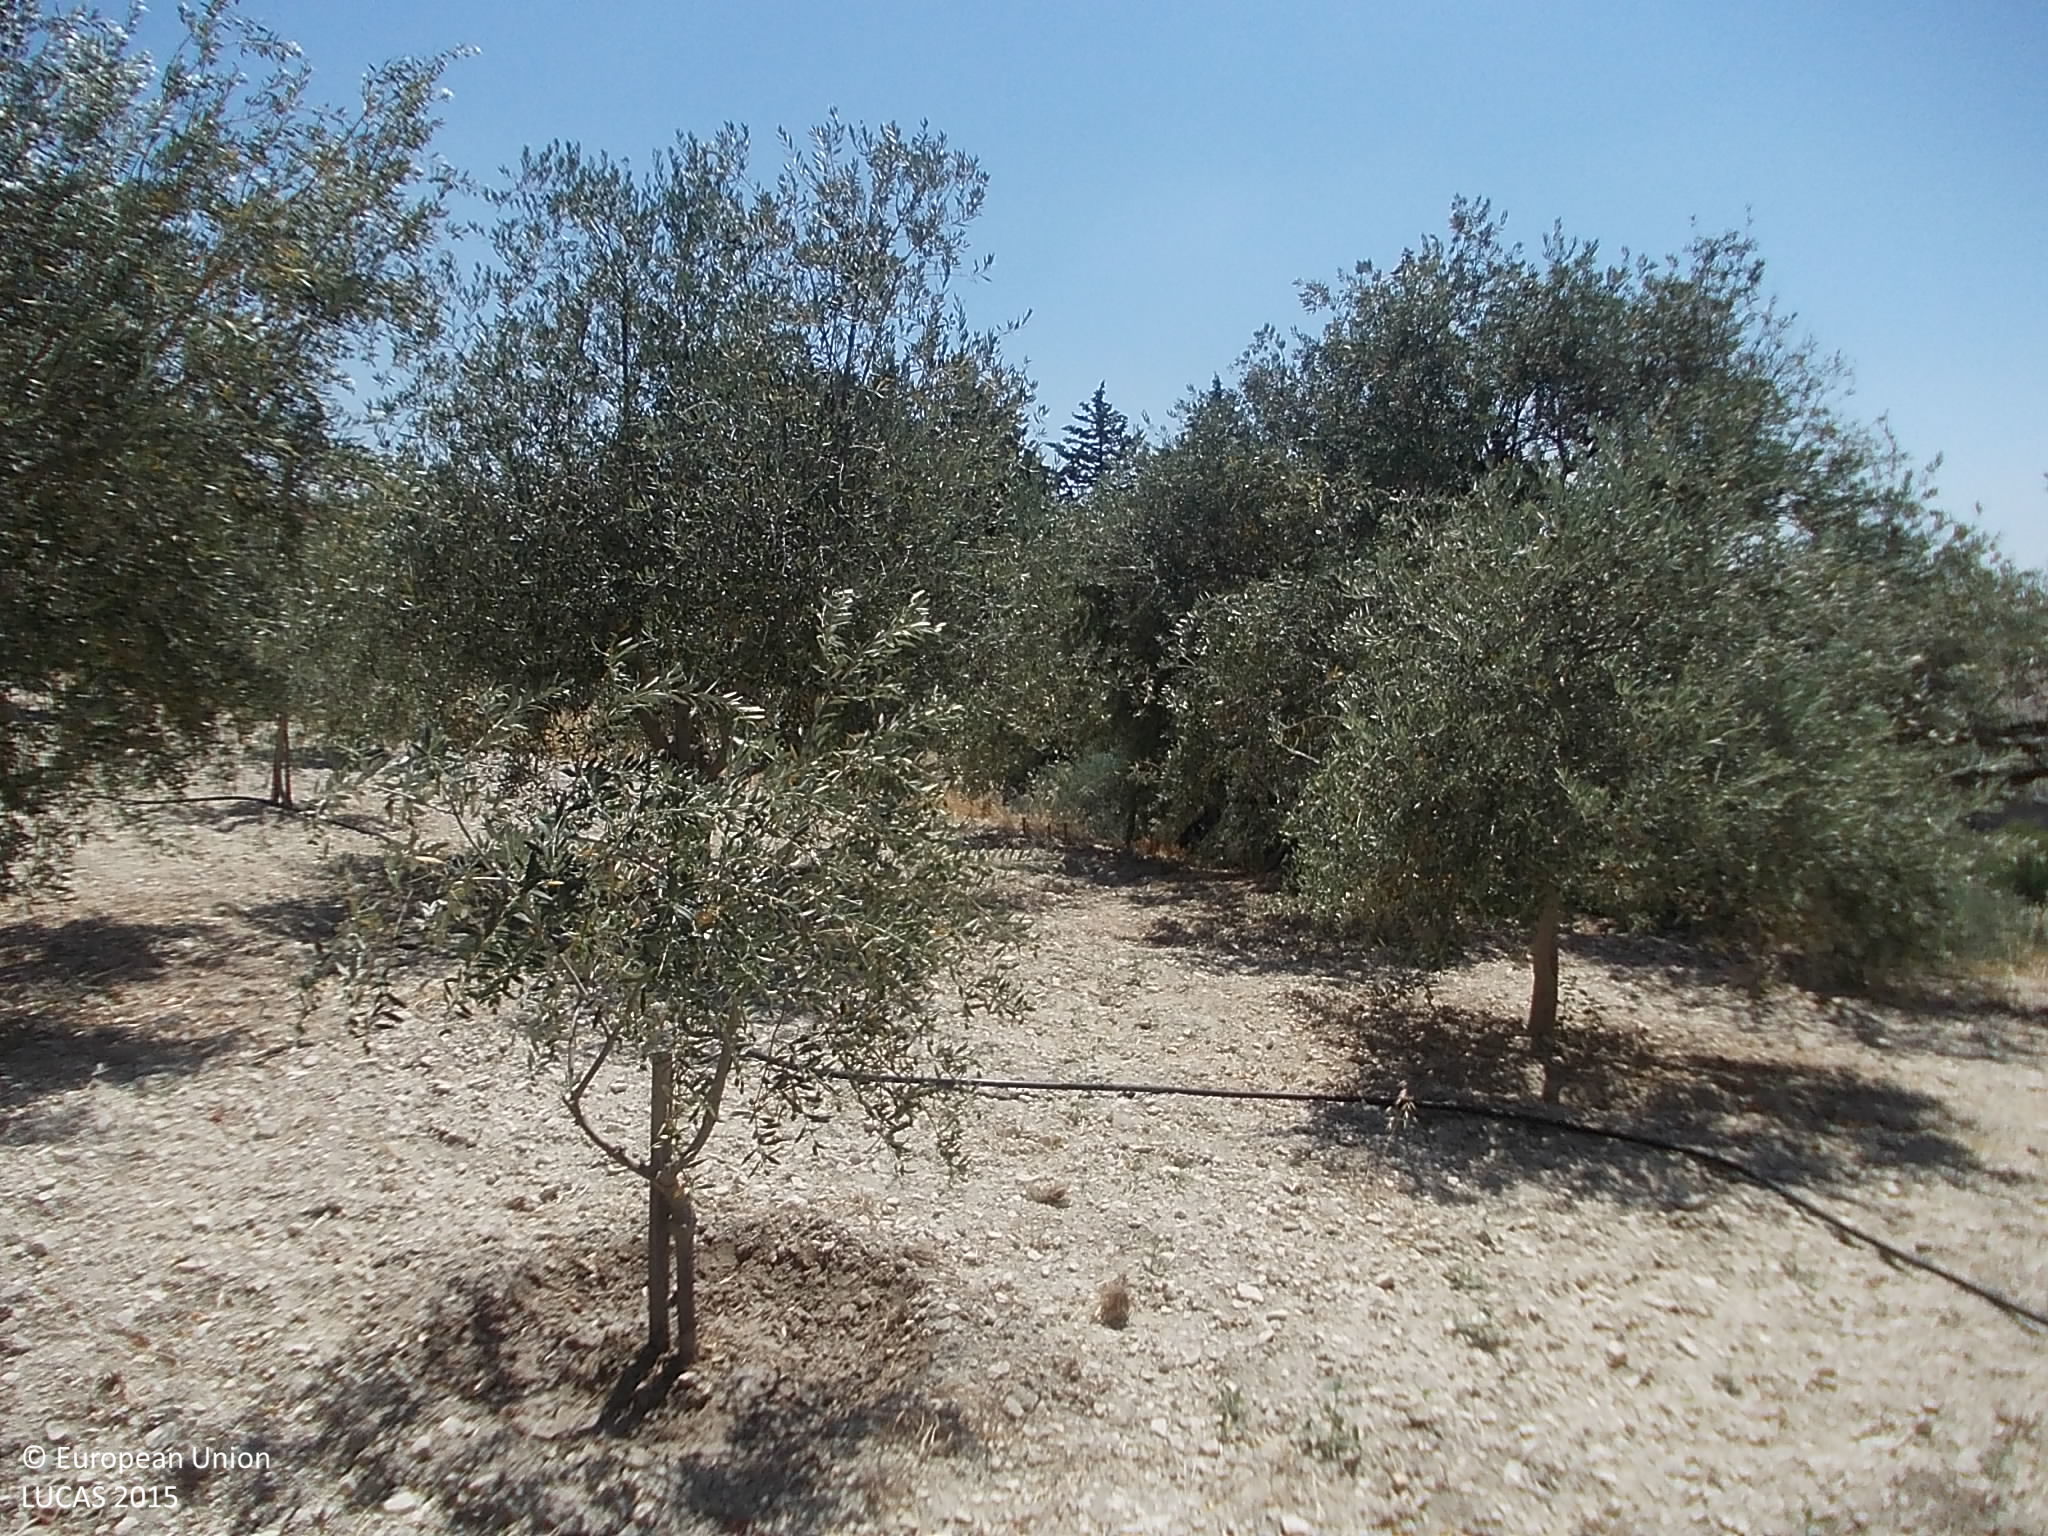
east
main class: Cropland
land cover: Olive groves
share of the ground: 25 - 50 %
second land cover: Other bare soil
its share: > 75 %
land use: Agriculture (excluding fallow land and kitchen gardens)
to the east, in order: Olive groves; Other bare soil; Other fruit trees and berries; Grassland without tree/shrub cover; Other fruit trees and berries; Paved roads, cycling and walking lanes; Olive groves; Dry stone walls; Olive groves; Paved roads, cycling and walking lanes; Grassland with sparse tree/shrub cover; Dry stone walls; Shrubland with sparse tree cover; Dry stone walls; Shrubland with sparse tree cover; Dry stone walls; Olive groves; Dry stone walls; Shrubland with sparse tree cover; Tracks; Grassland with sparse tree/shrub cover
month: July
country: CY
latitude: 34.7972
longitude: 32.8404
